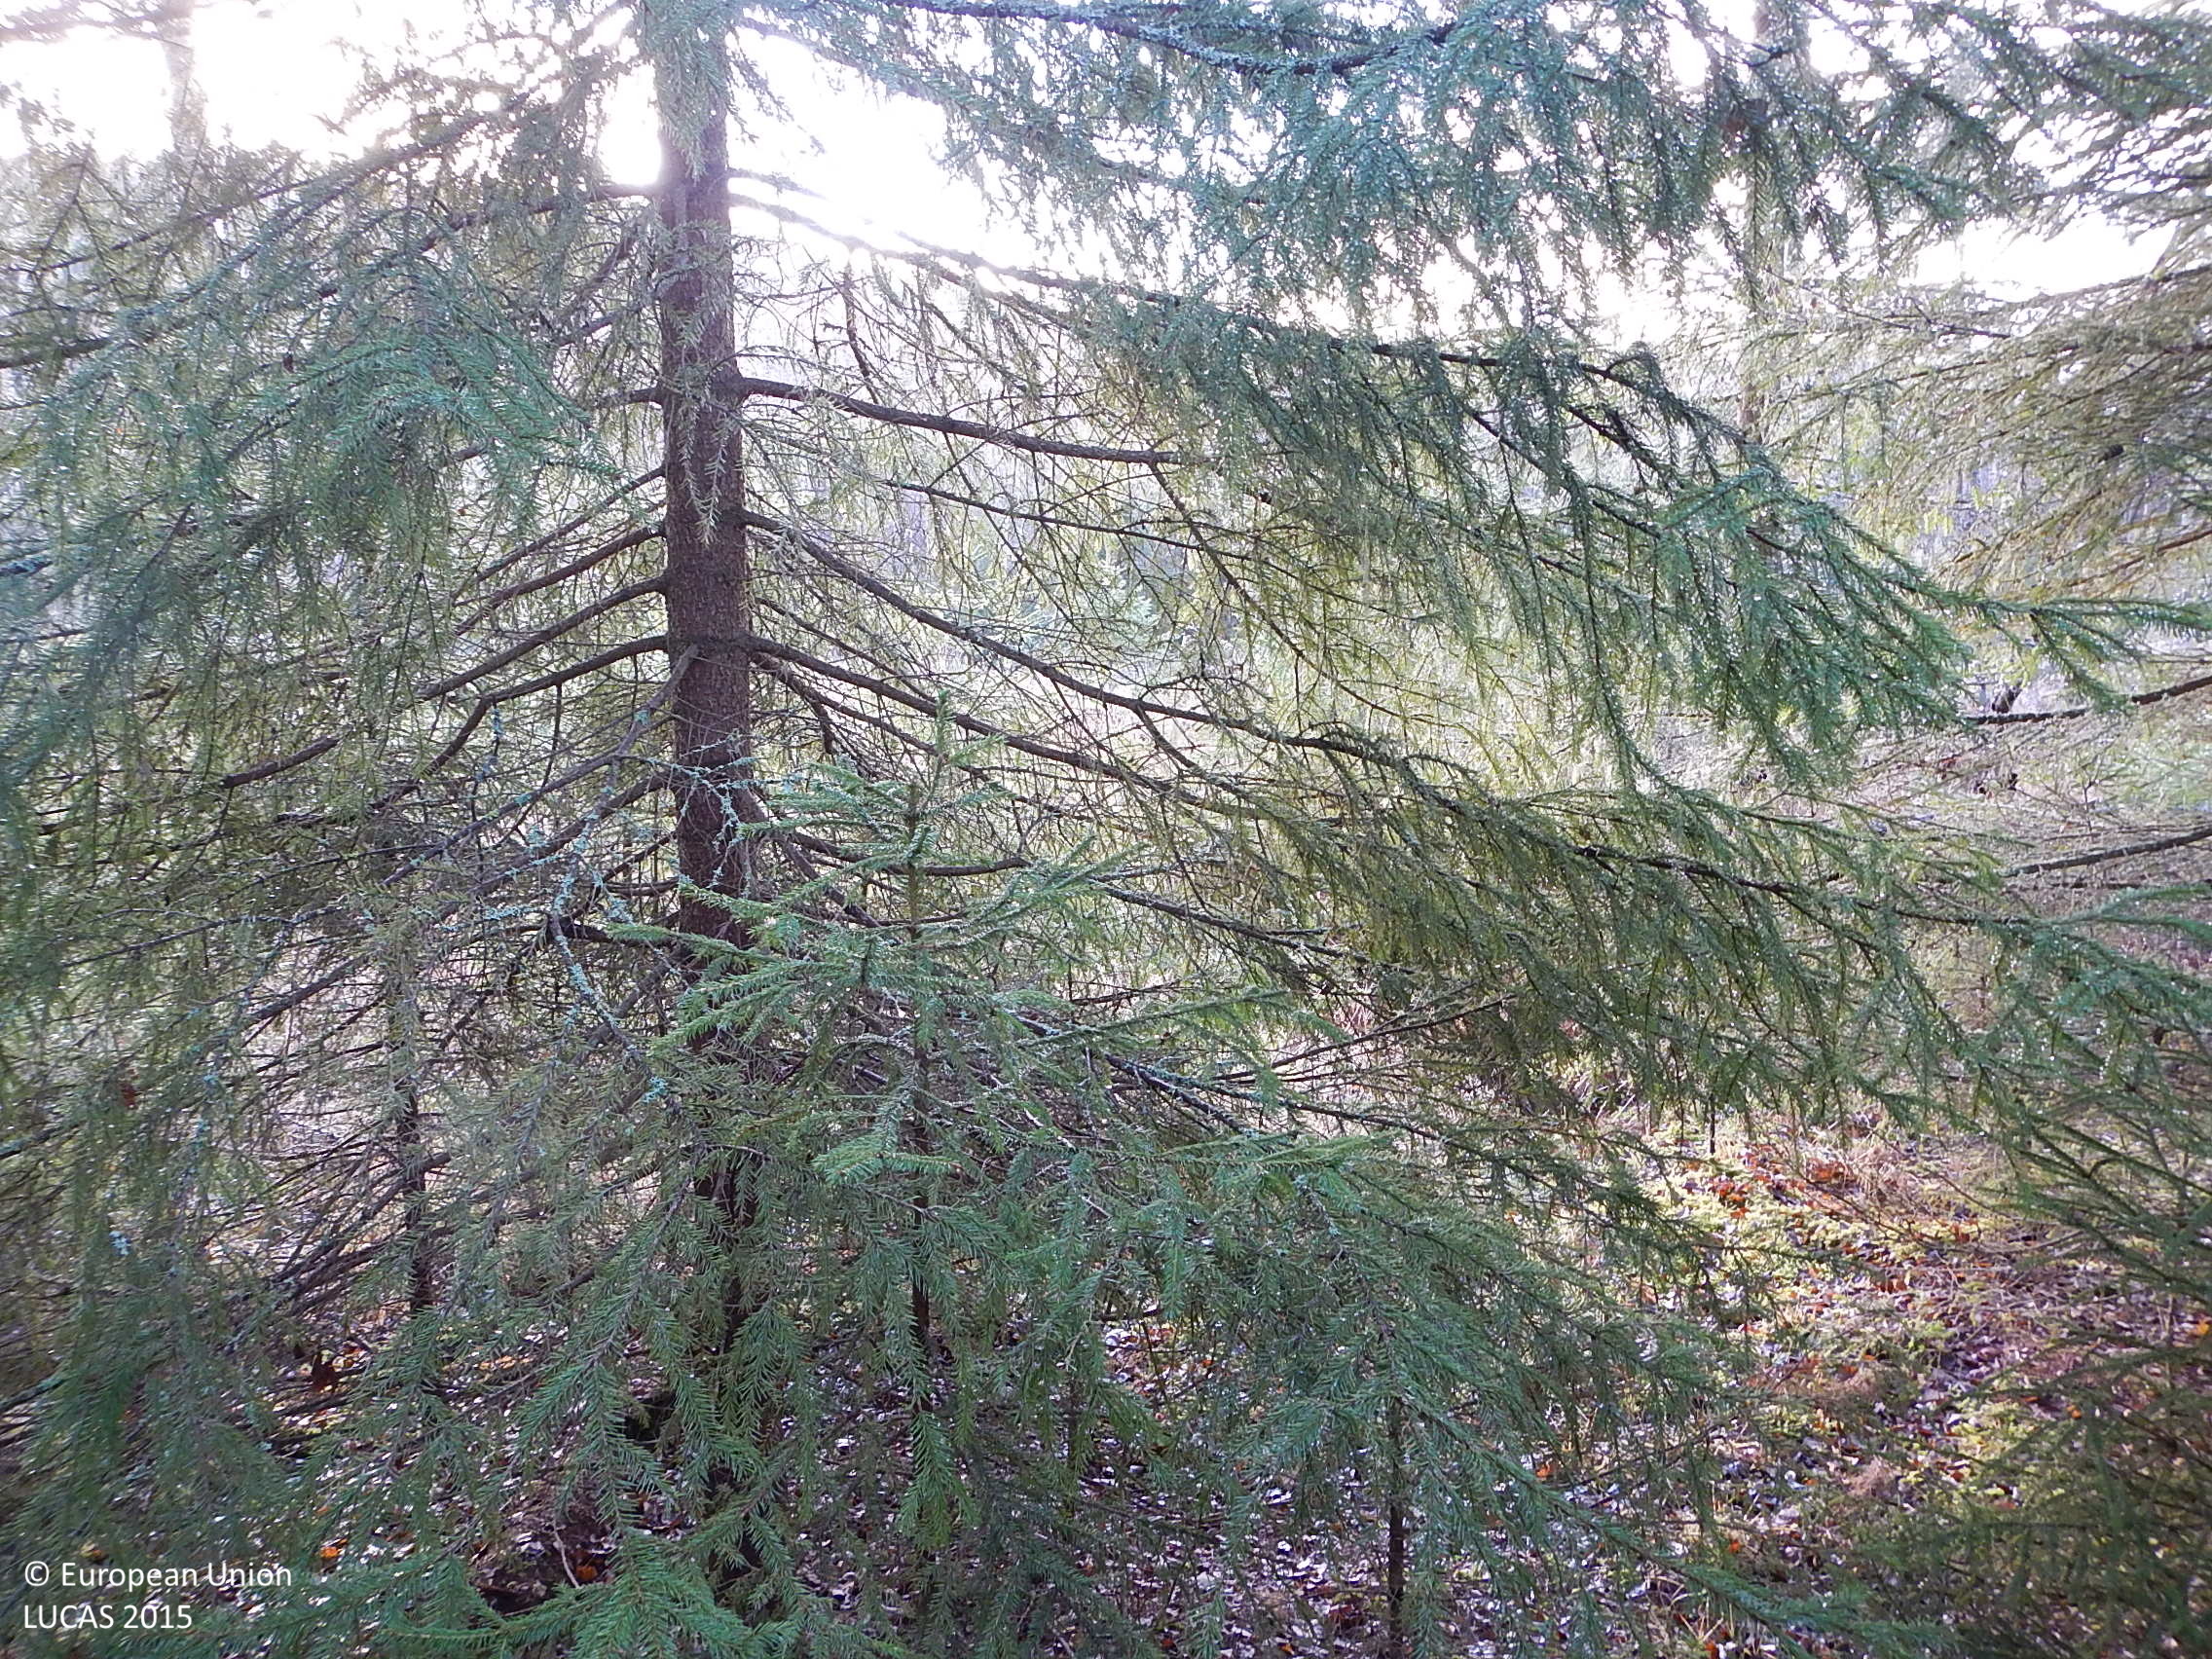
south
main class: Woodland
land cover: Spruce dominated mixed woodland
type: boreal forest
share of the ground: 50 - 75 %
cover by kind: coniferous forest trees 45 %, broadleaved forest trees 25 %, herbaceous plants 15 %, lichens and mosses 10 %, shrubs 5 %
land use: Forestry
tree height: > 5 m
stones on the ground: < 10 %
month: November
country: SE
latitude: 61.7536
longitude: 16.7830
